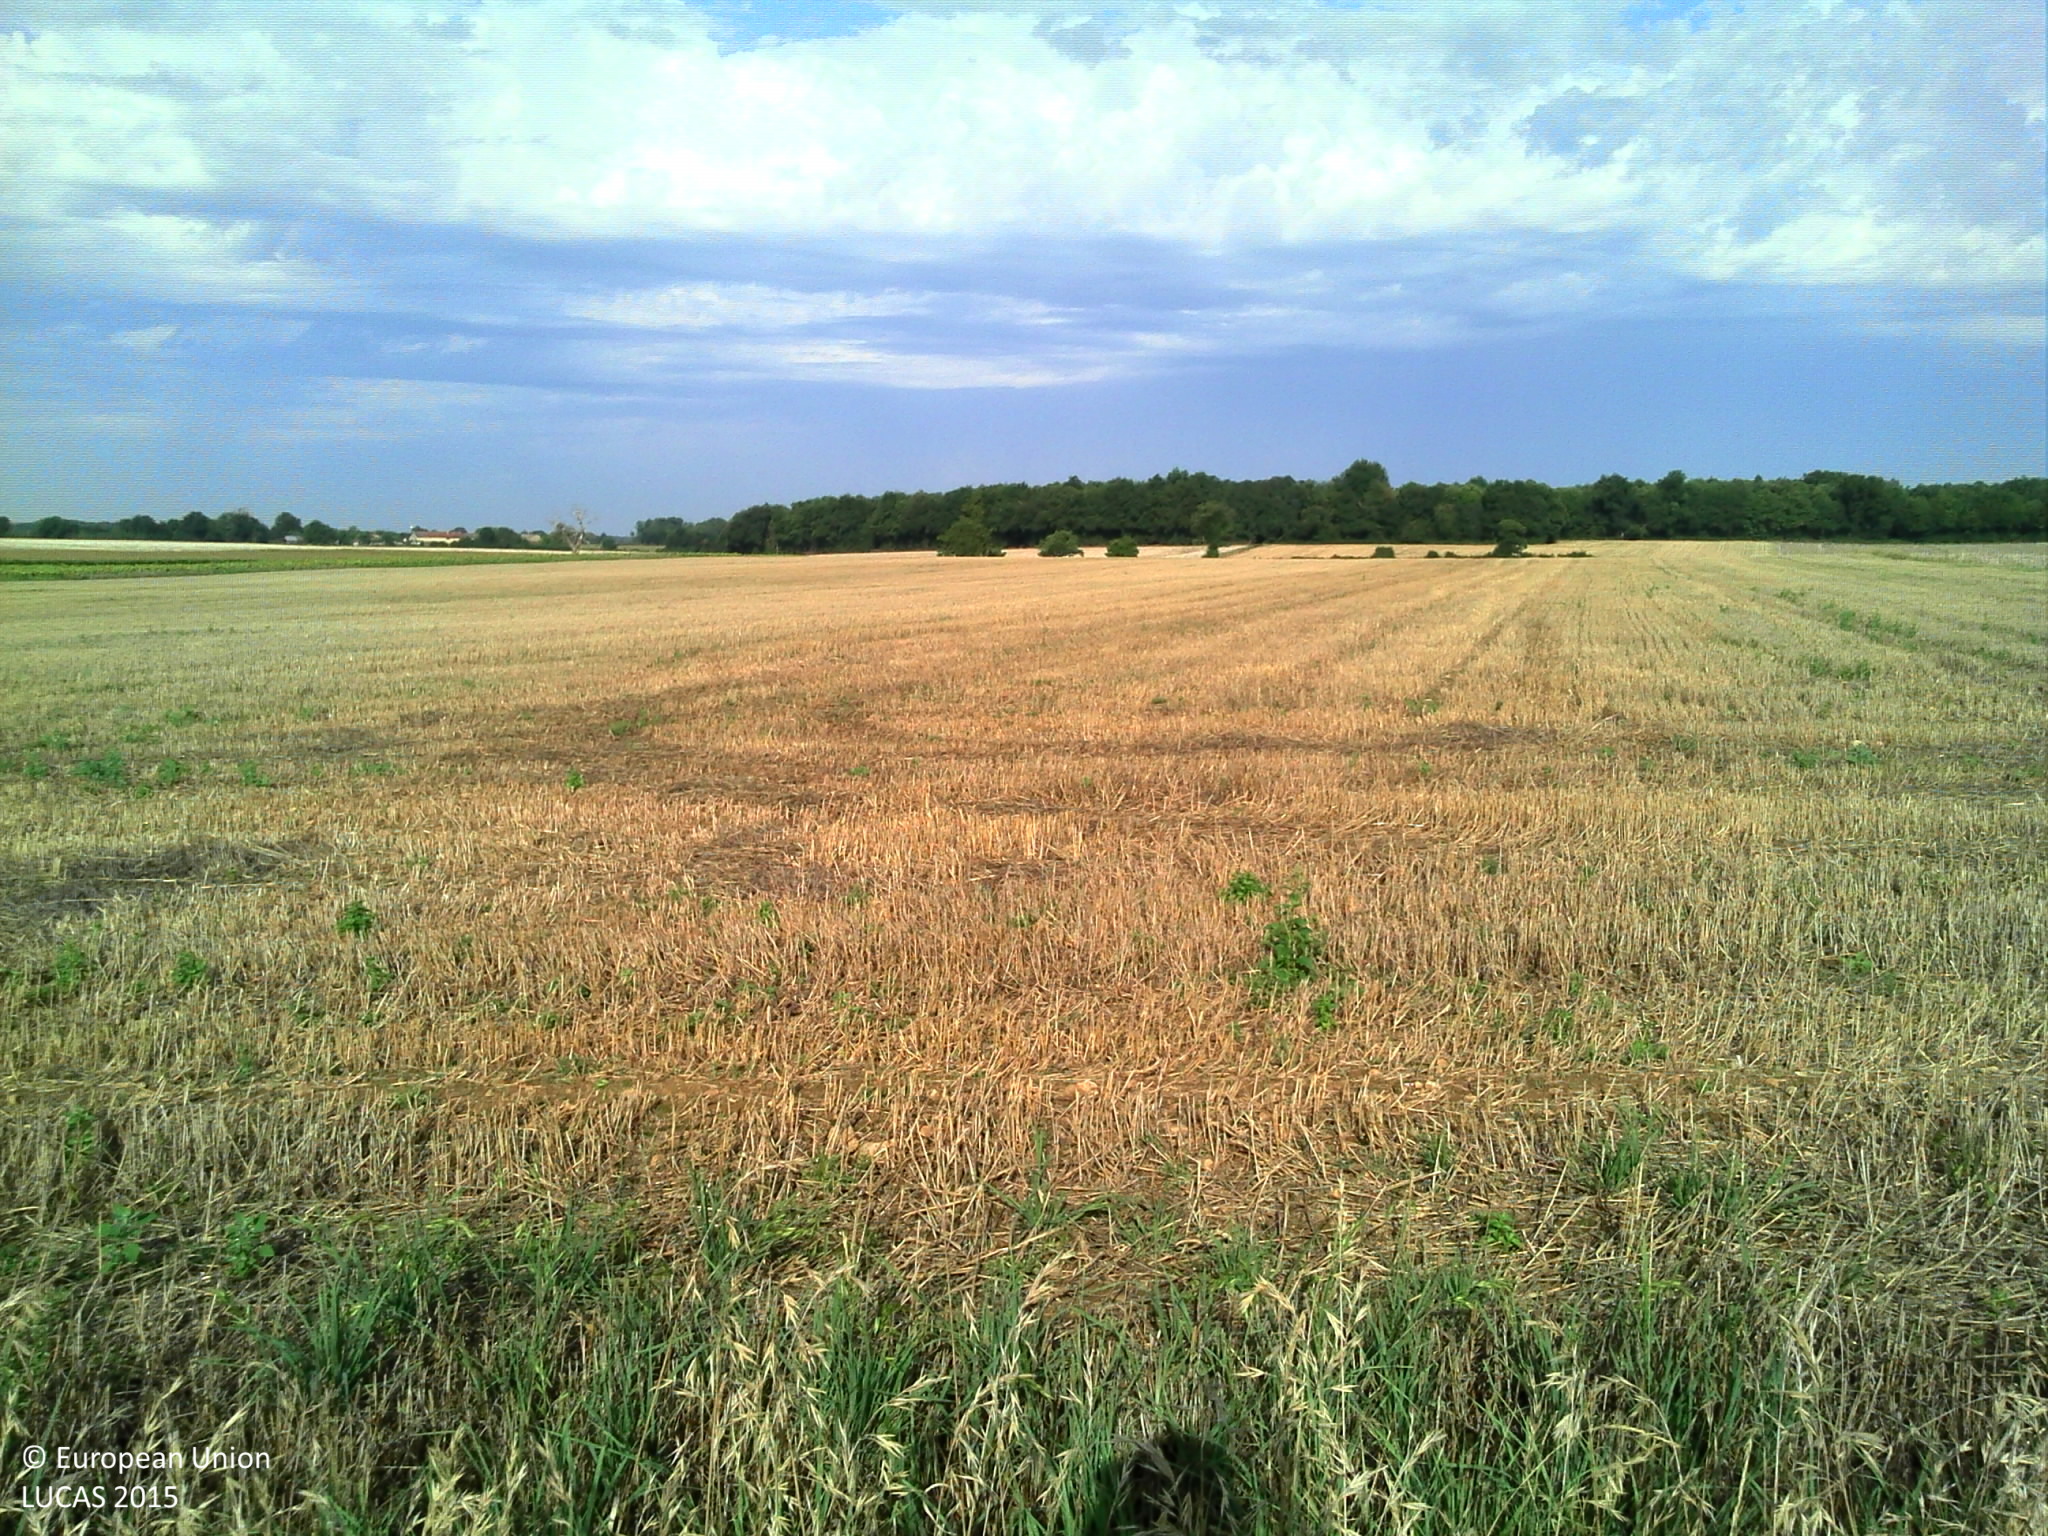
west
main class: Cropland
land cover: Other cereals
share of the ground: > 75 %
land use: Agriculture (excluding fallow land and kitchen gardens)
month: August
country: FR
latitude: 46.1819
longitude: 0.3050
